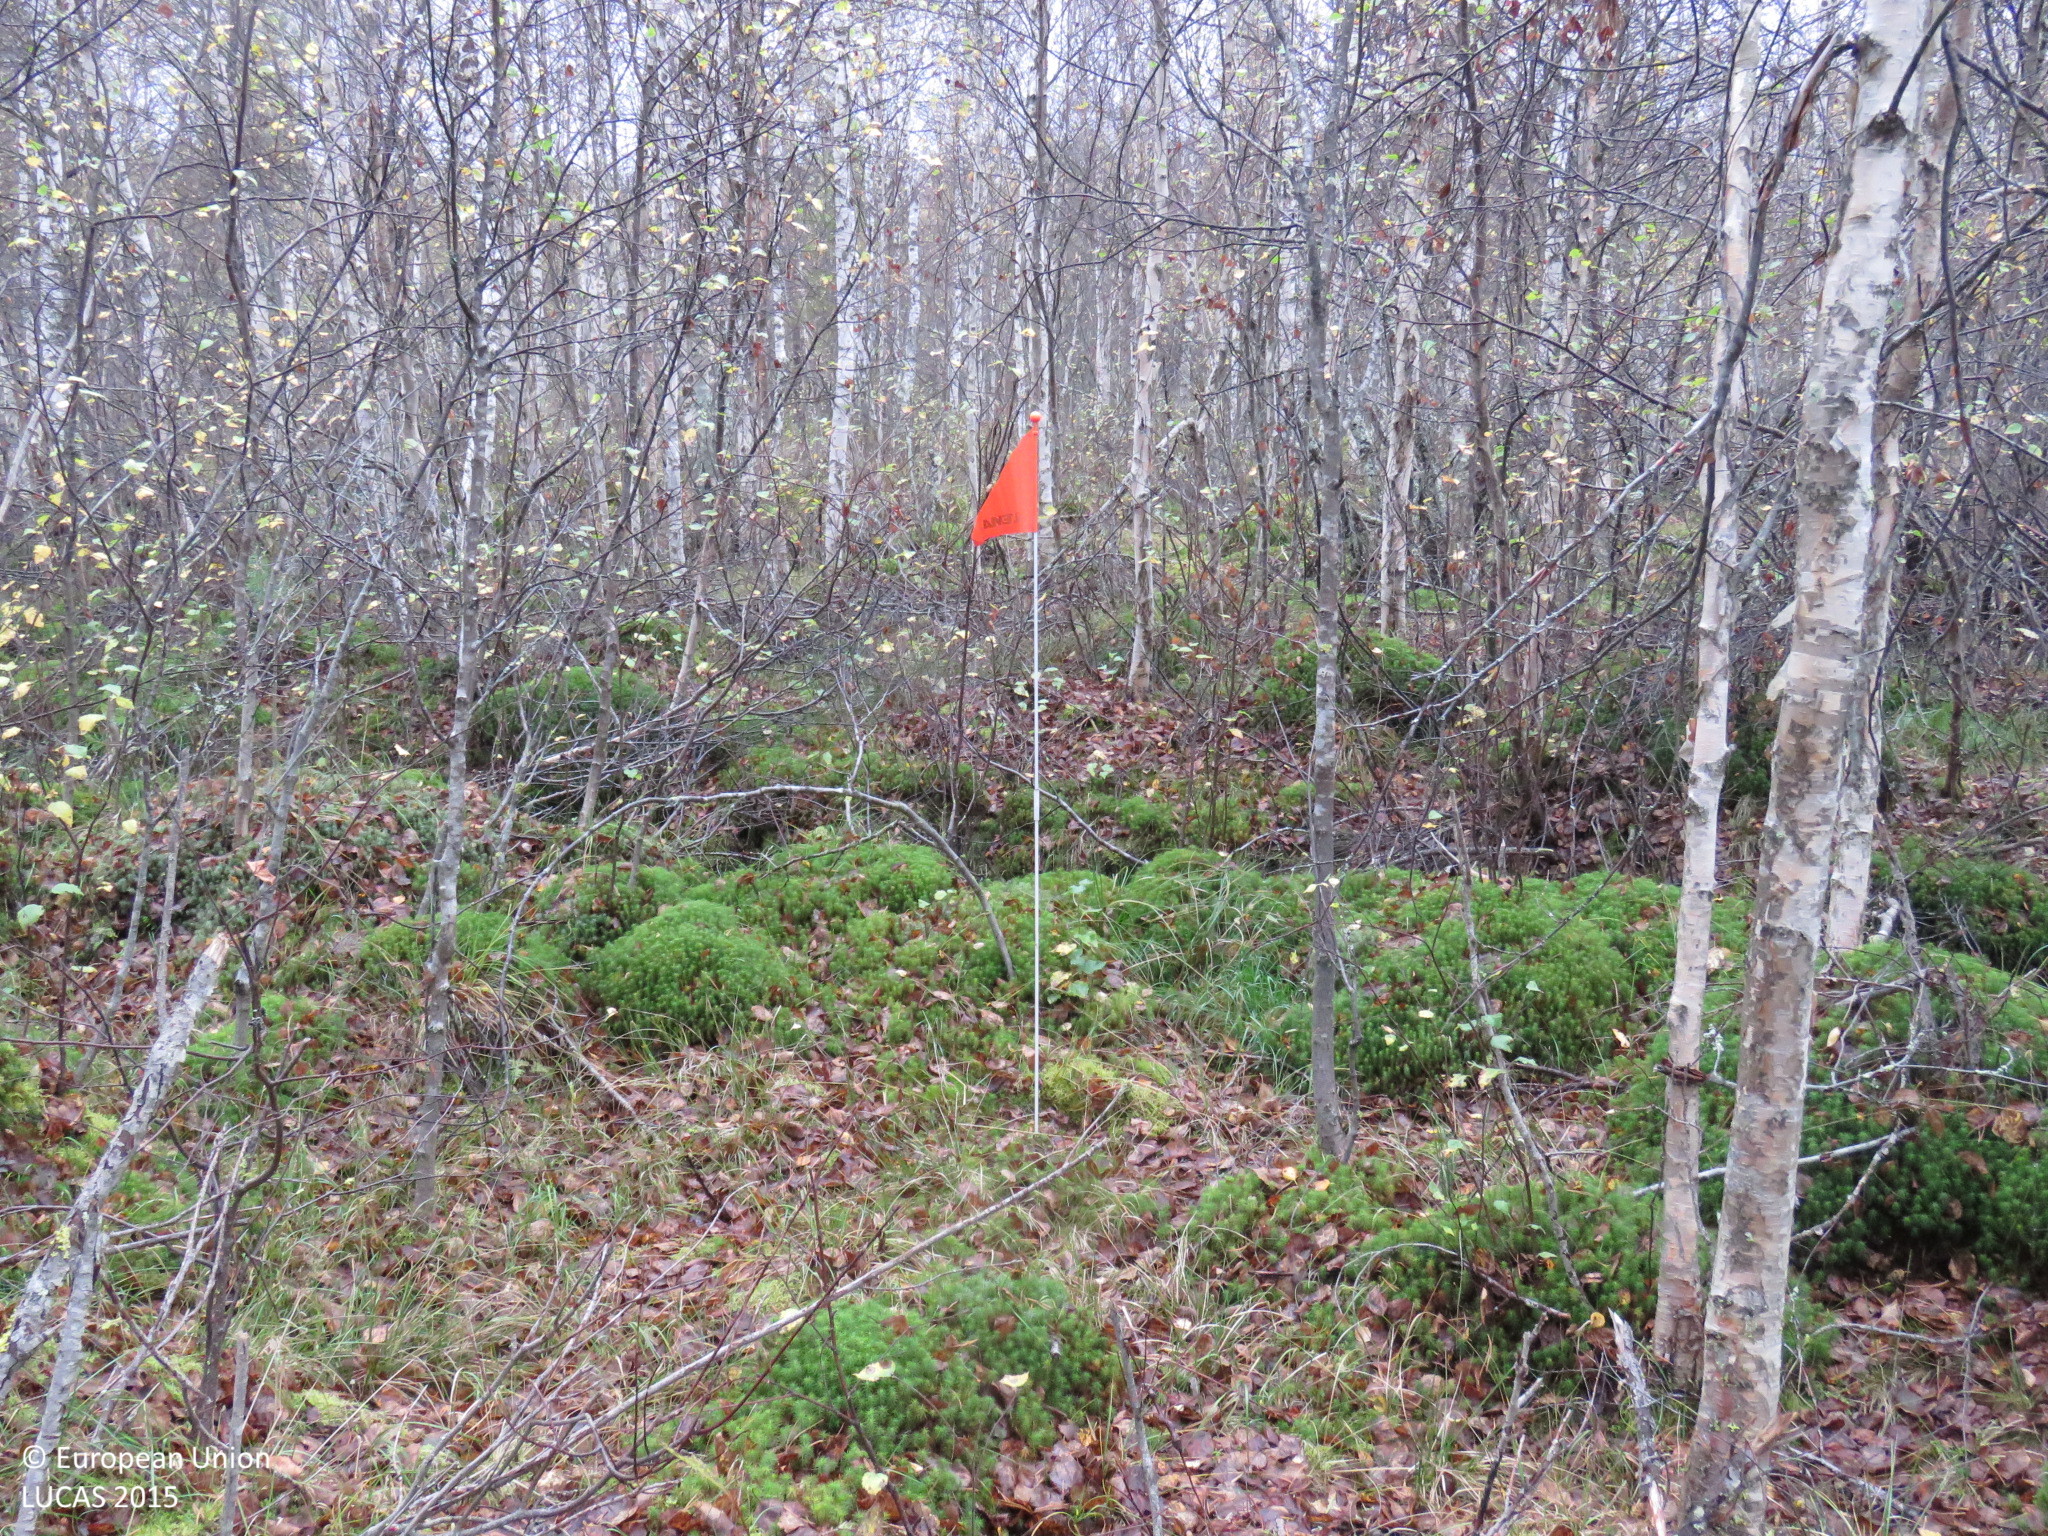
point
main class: Woodland
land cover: Broadleaved woodland
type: mire and swamp forests
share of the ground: > 75 %
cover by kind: broadleaved forest trees 70 %, coniferous forest trees 10 %, herbaceous plants 10 %, lichens and mosses 10 %
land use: Forestry
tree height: > 5 m
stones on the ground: < 10 %
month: September
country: FI
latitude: 65.1924
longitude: 26.8837
